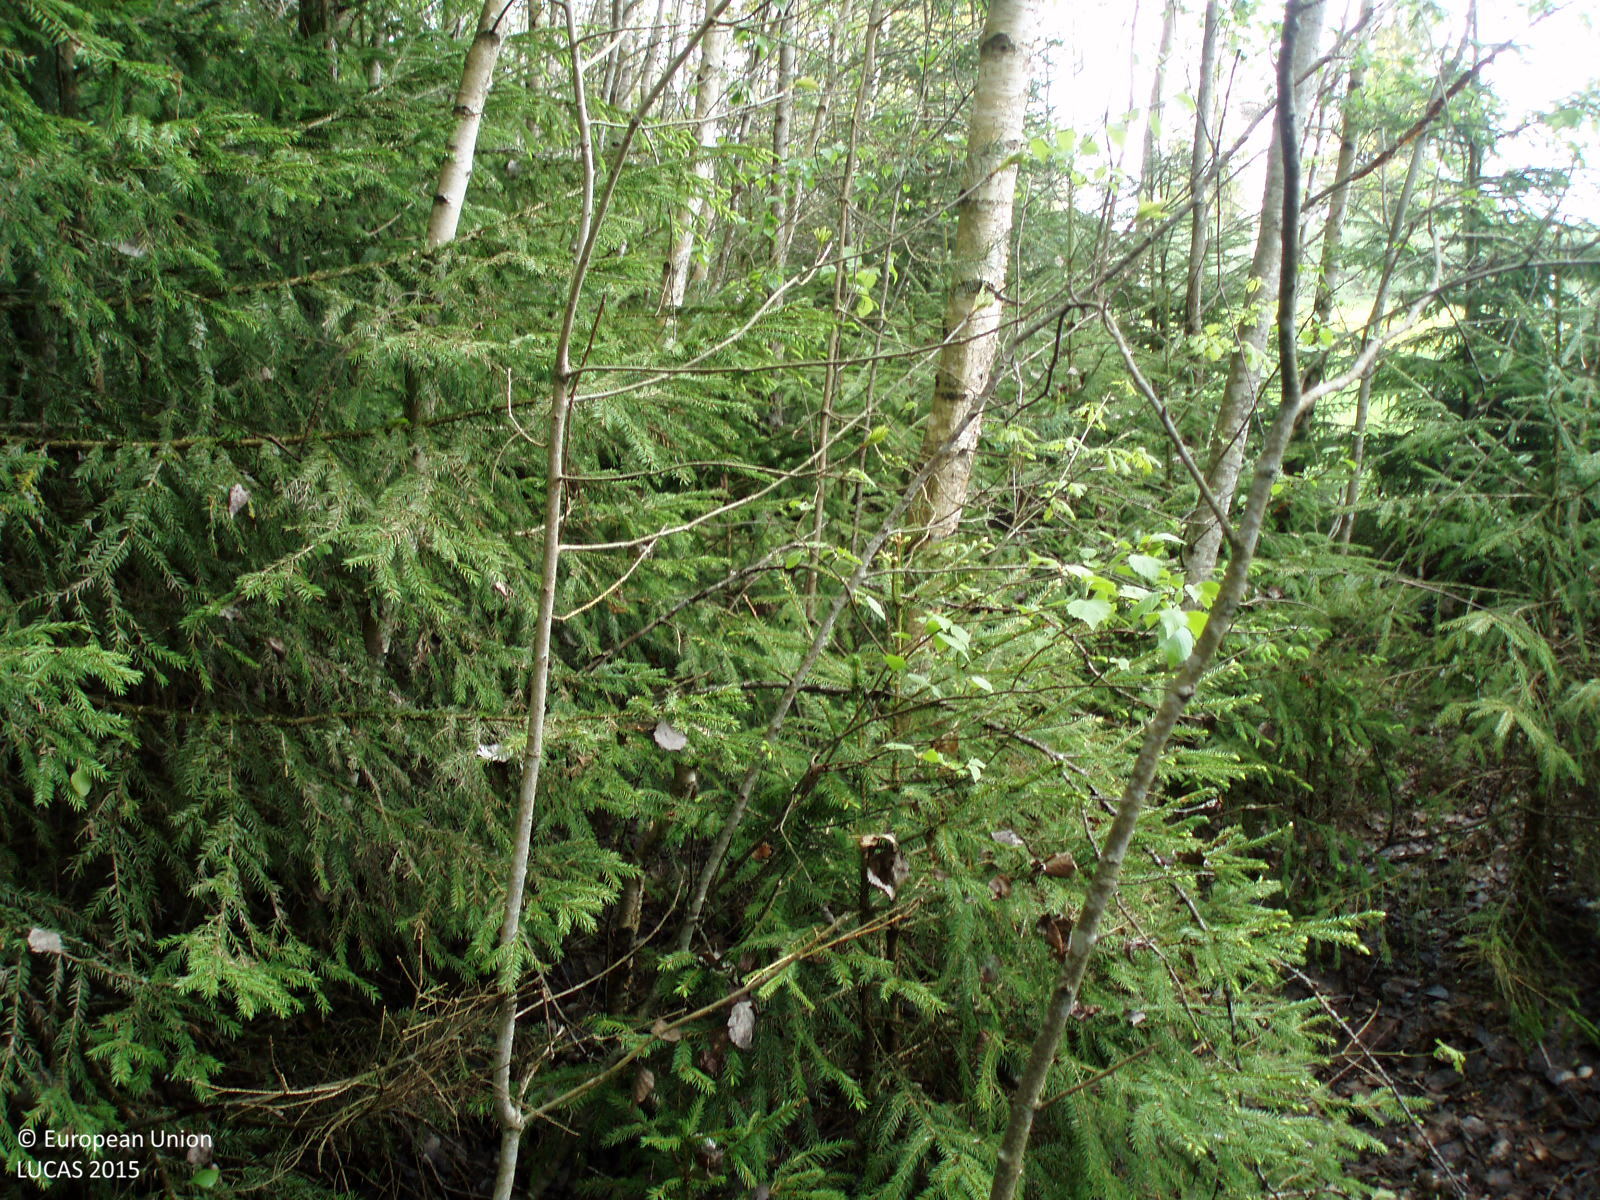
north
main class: Woodland
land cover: Spruce dominated mixed woodland
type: hemiboreal forest and nemoral coniferous forest and mixed broadleaved-coniferous forest
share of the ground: > 75 %
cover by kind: broadleaved forest trees 60 %, coniferous forest trees 40 %
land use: Forestry
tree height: > 5 m
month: May
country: LT
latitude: 56.2766
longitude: 22.5760
